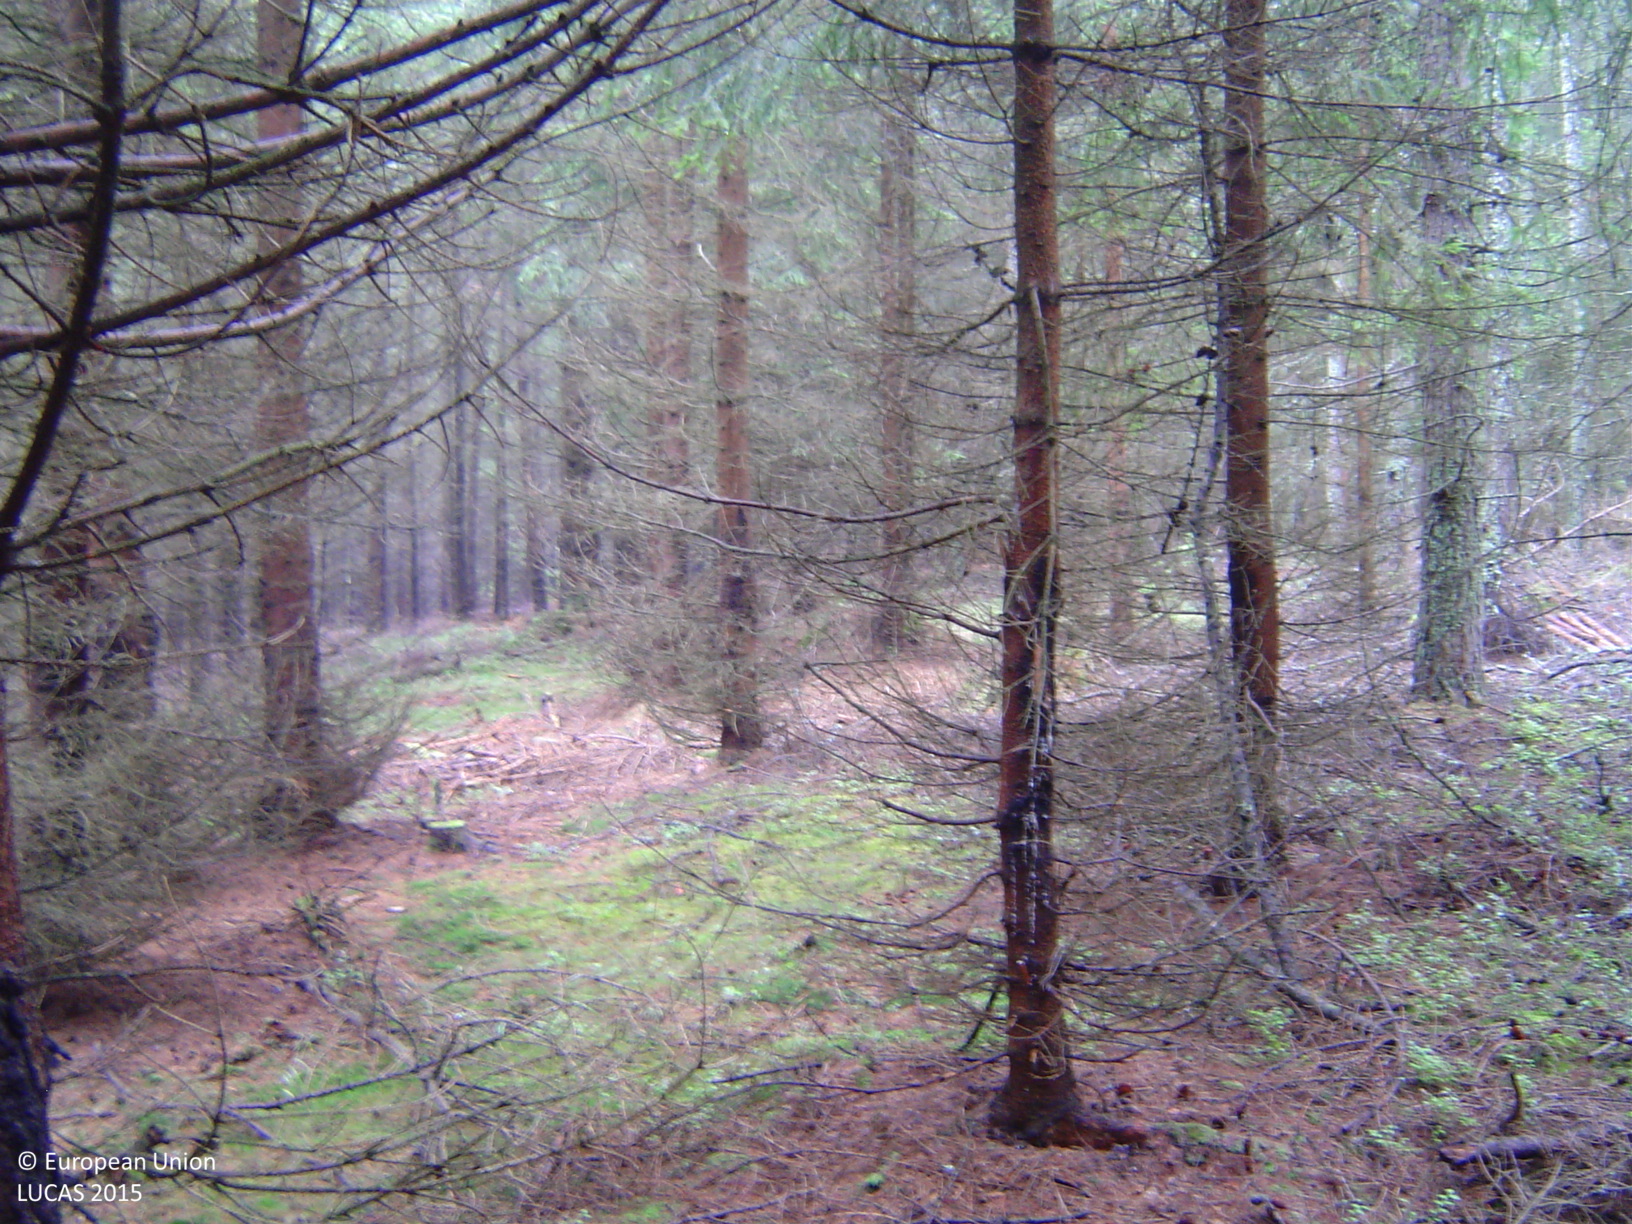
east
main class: Woodland
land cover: Spruce dominated coniferous woodland
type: hemiboreal forest and nemoral coniferous forest and mixed broadleaved-coniferous forest
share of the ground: > 75 %
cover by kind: coniferous forest trees 100 %
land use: Forestry
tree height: > 5 m
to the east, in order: Spruce dominated coniferous woodland
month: August
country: CZ
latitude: 49.6885
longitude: 13.8124
